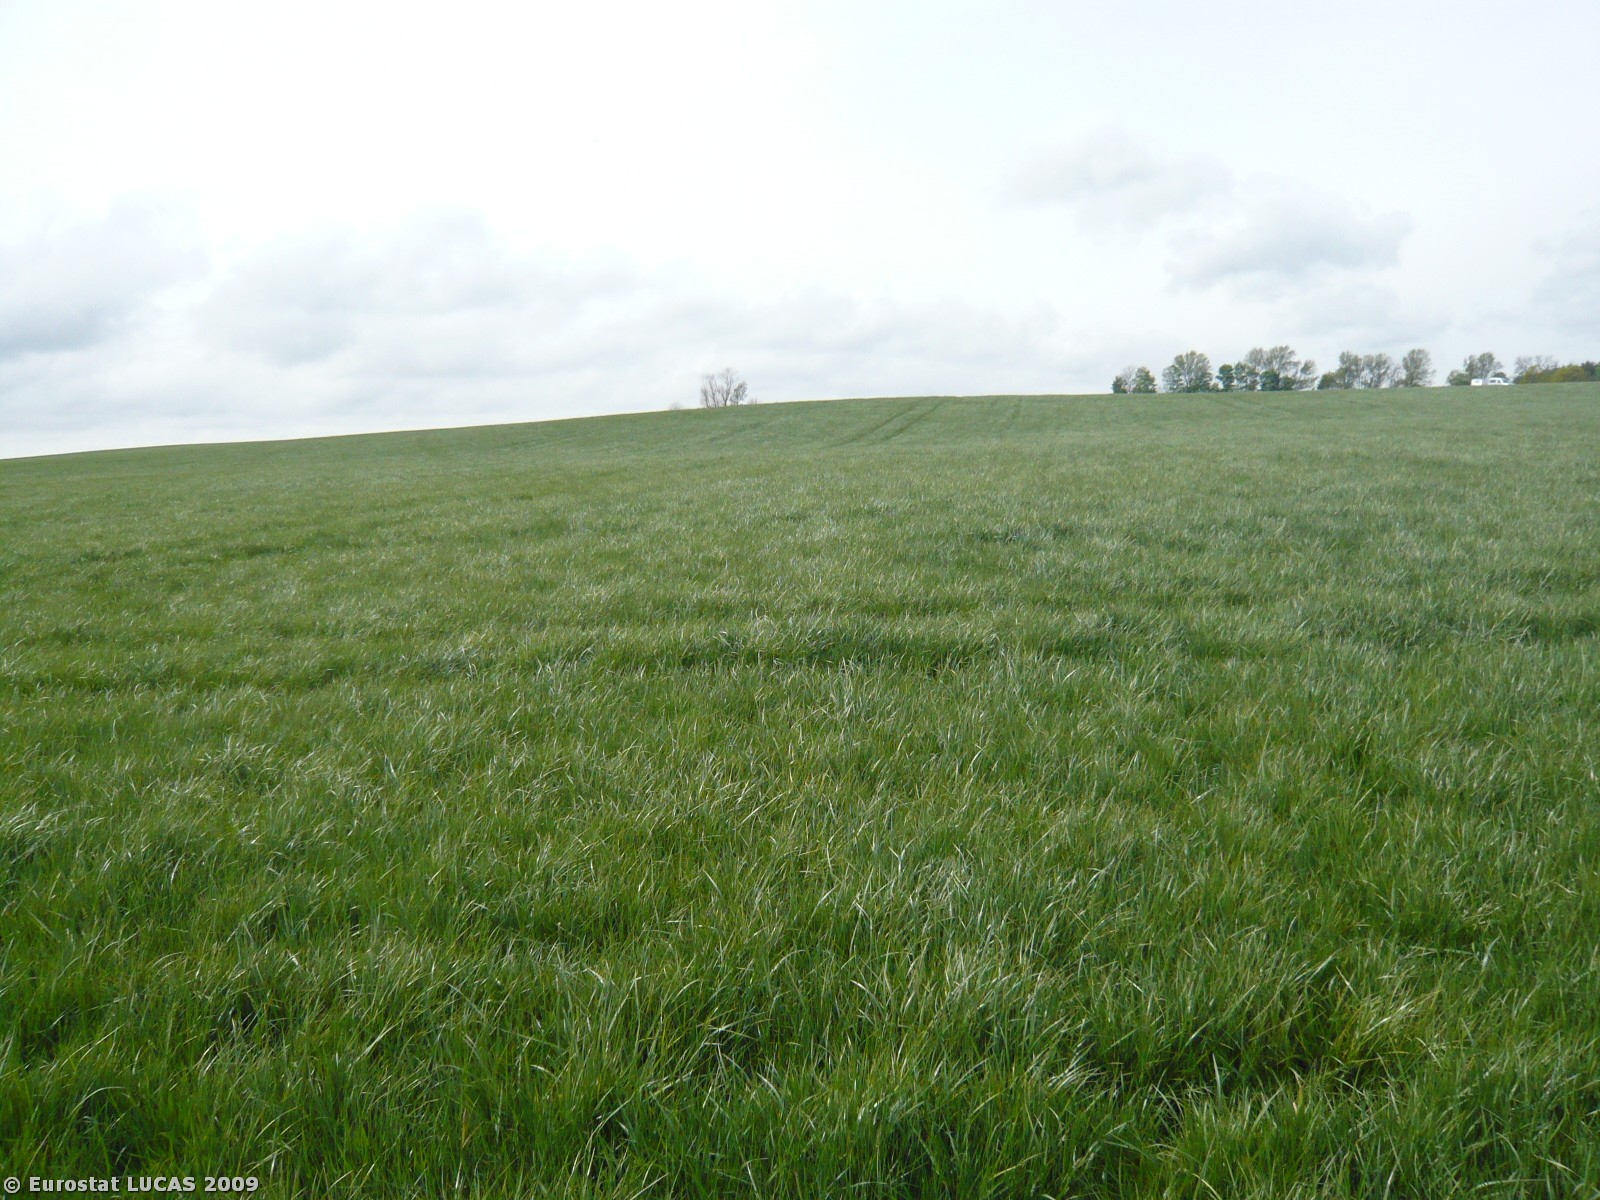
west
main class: Grassland
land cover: Grassland without tree/shrub cover
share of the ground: > 75 %
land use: Agriculture (excluding fallow land and kitchen gardens)
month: May
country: DK
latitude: 55.2537
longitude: 12.0909
